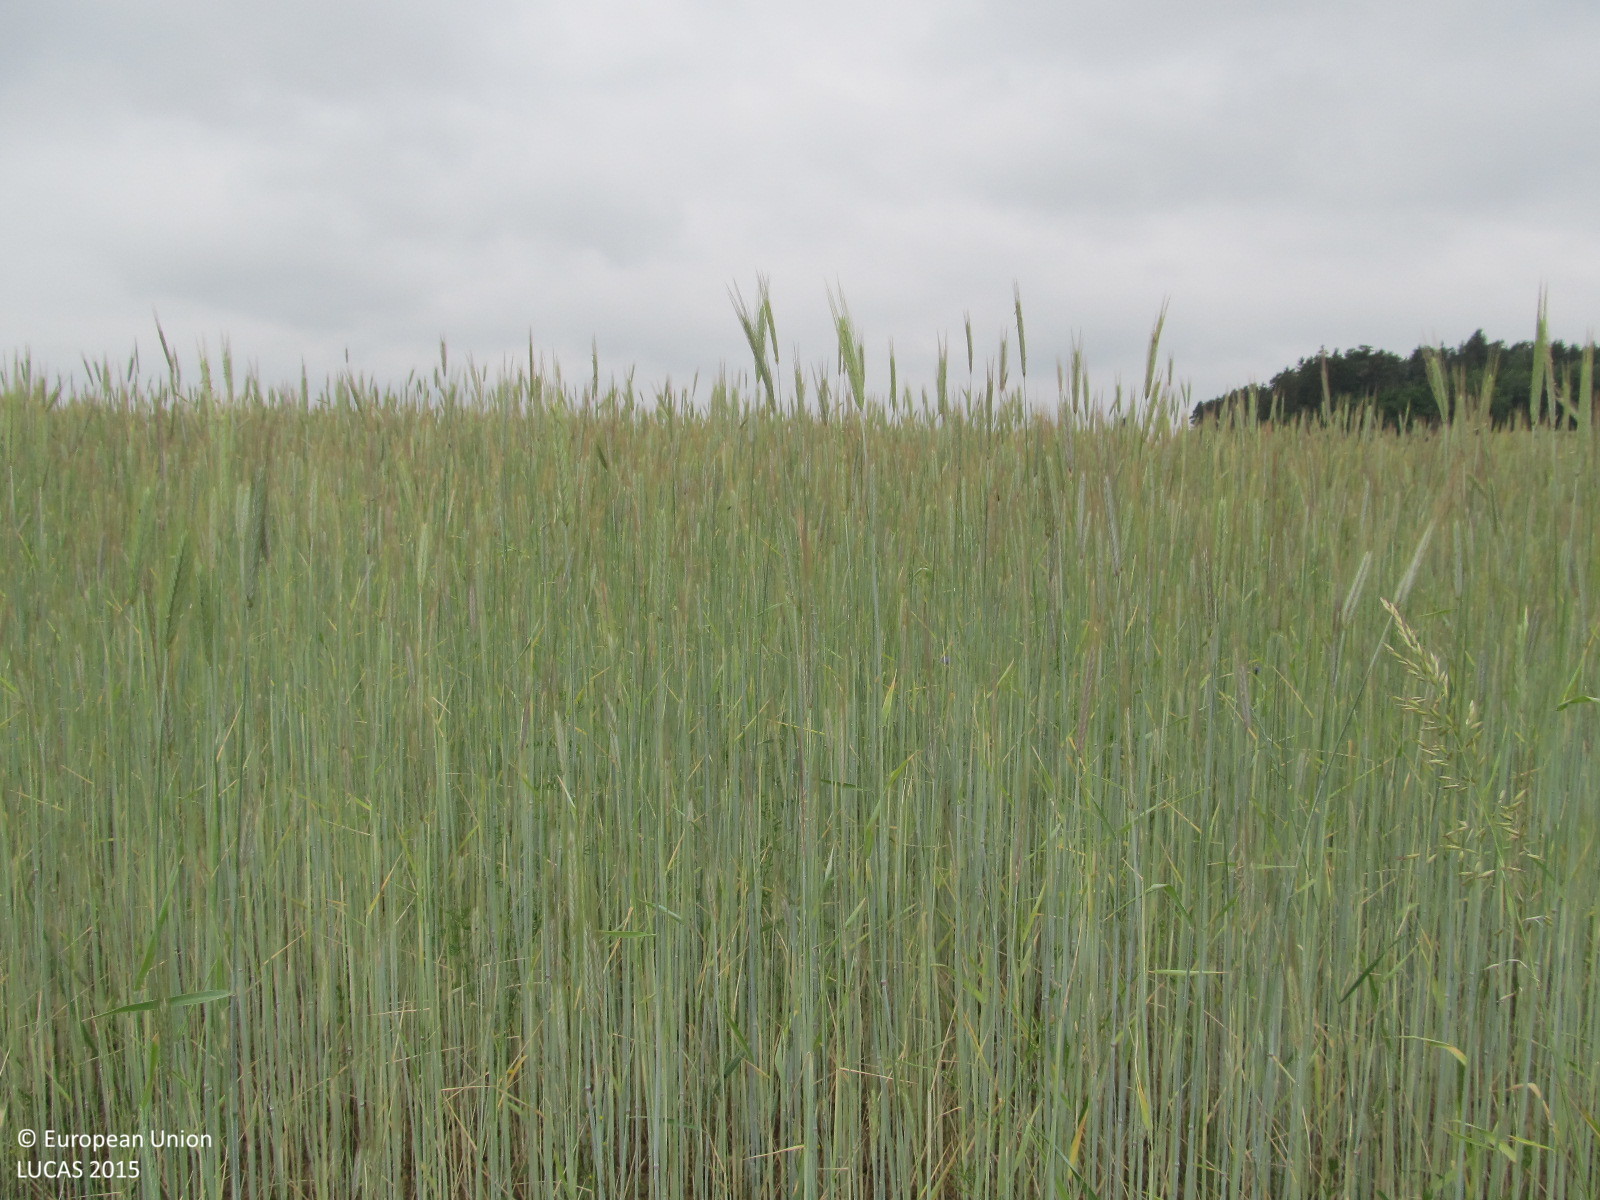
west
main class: Cropland
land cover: Rye
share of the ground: > 75 %
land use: Agriculture (excluding fallow land and kitchen gardens)
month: June
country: AT
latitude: 48.5749
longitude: 15.4649
